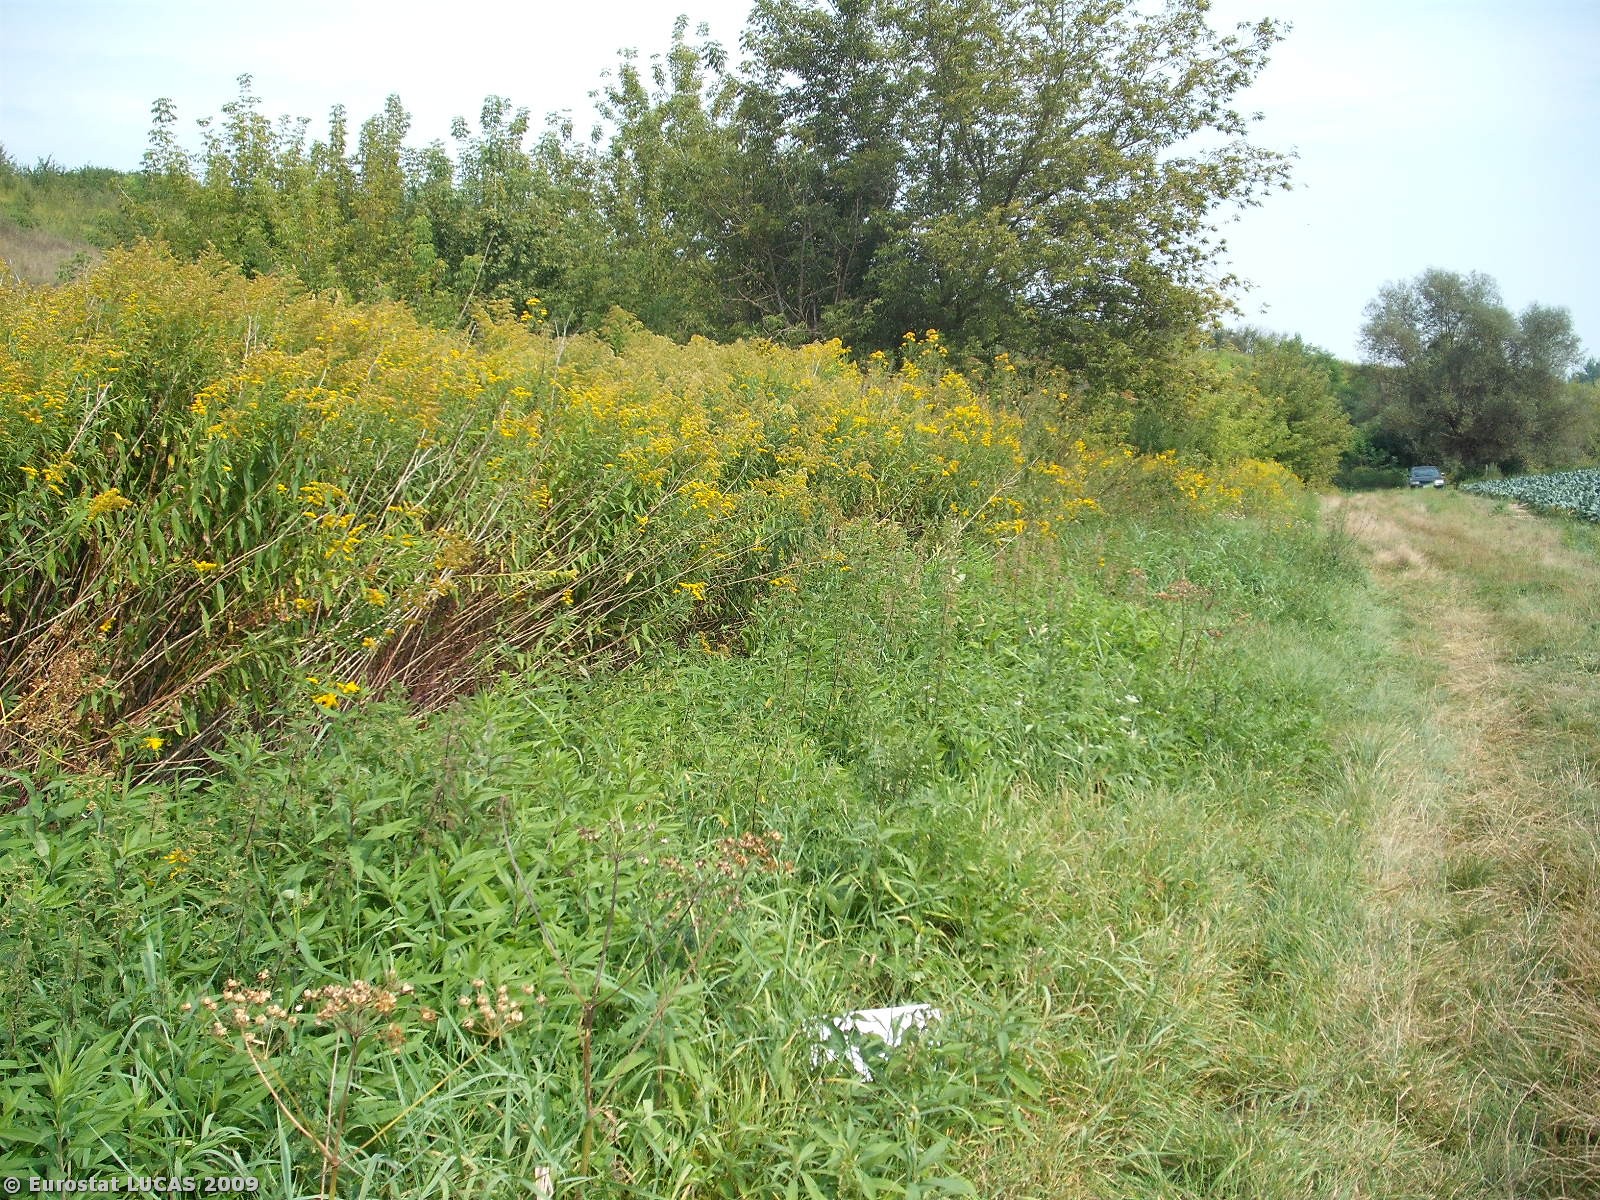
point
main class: Grassland
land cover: Spontaneously vegetated surfaces
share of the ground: > 75 %
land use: Unused
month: August
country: PL
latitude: 50.8031
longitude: 21.8186
